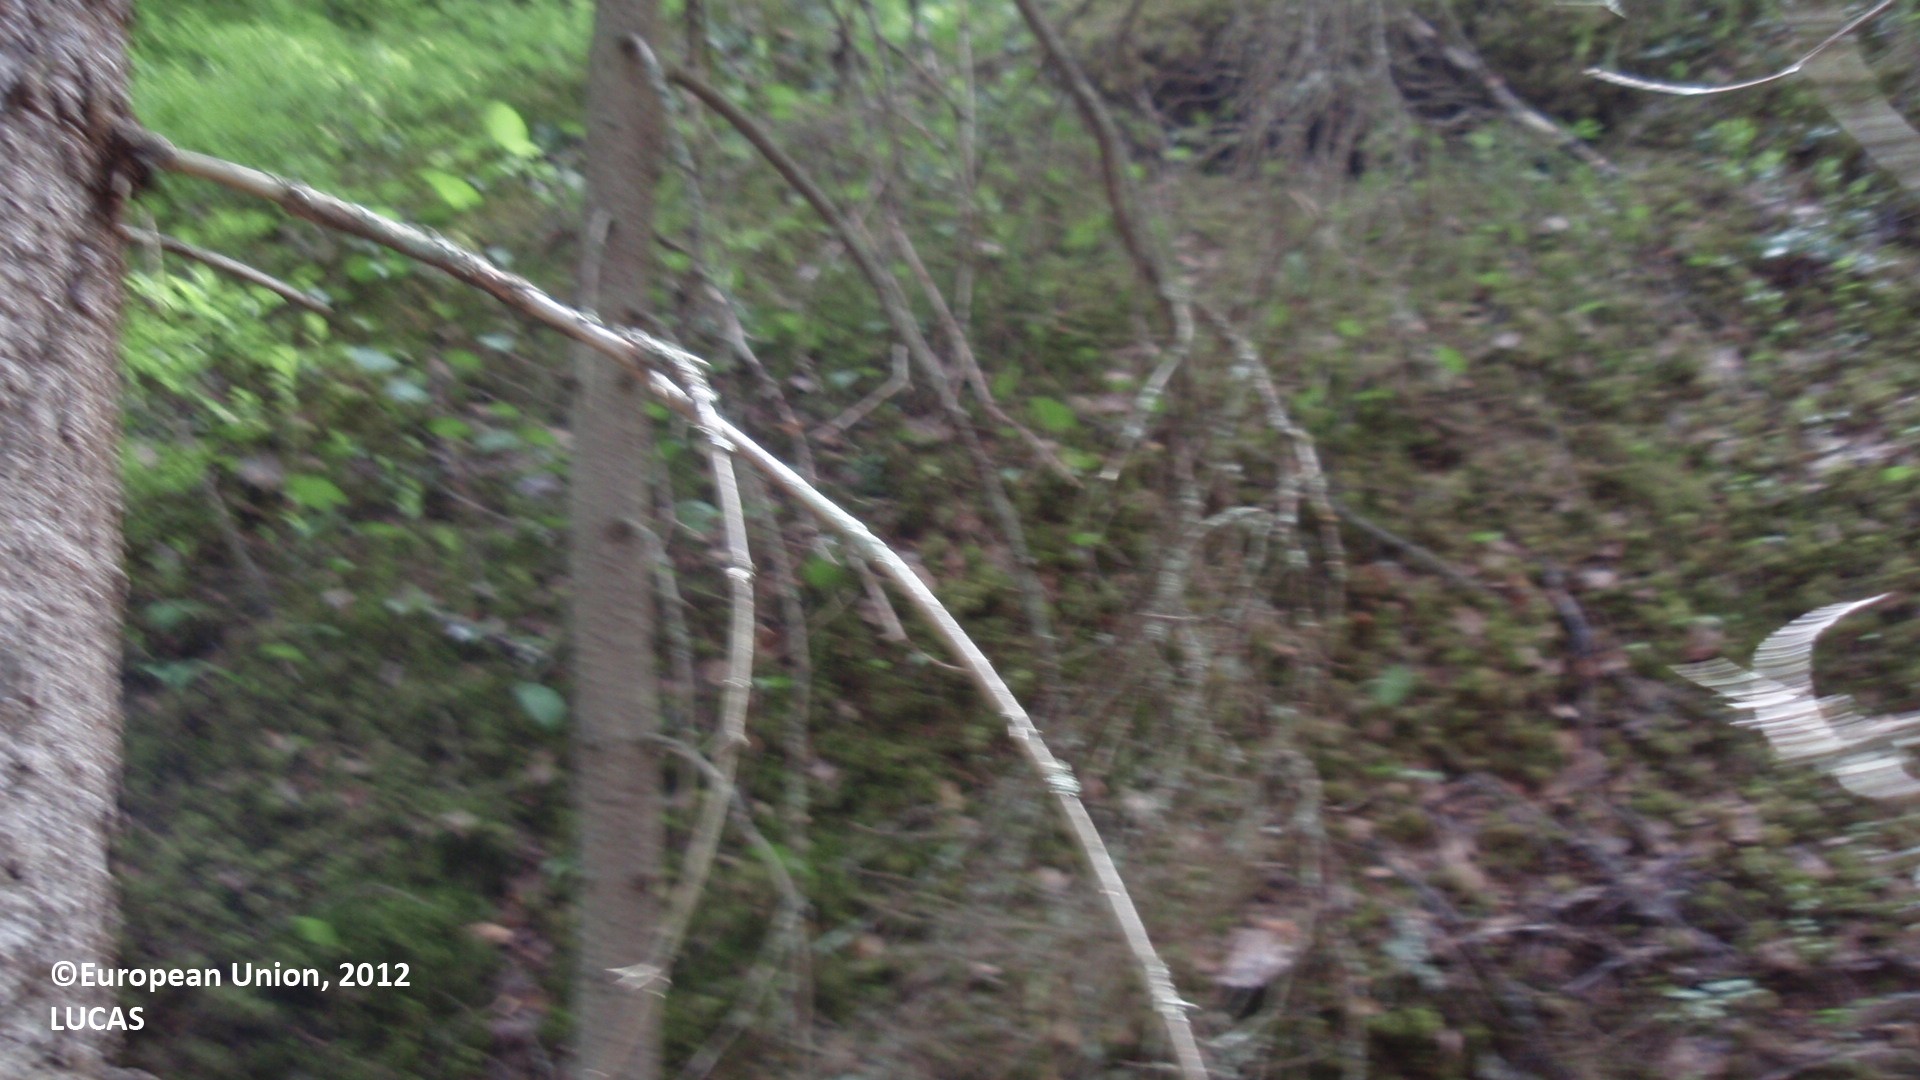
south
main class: Woodland
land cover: Spruce dominated mixed woodland
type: boreal forest
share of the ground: 25 - 50 %
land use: Forestry
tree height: > 5 m
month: June
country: FI
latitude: 61.3938
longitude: 26.9948
